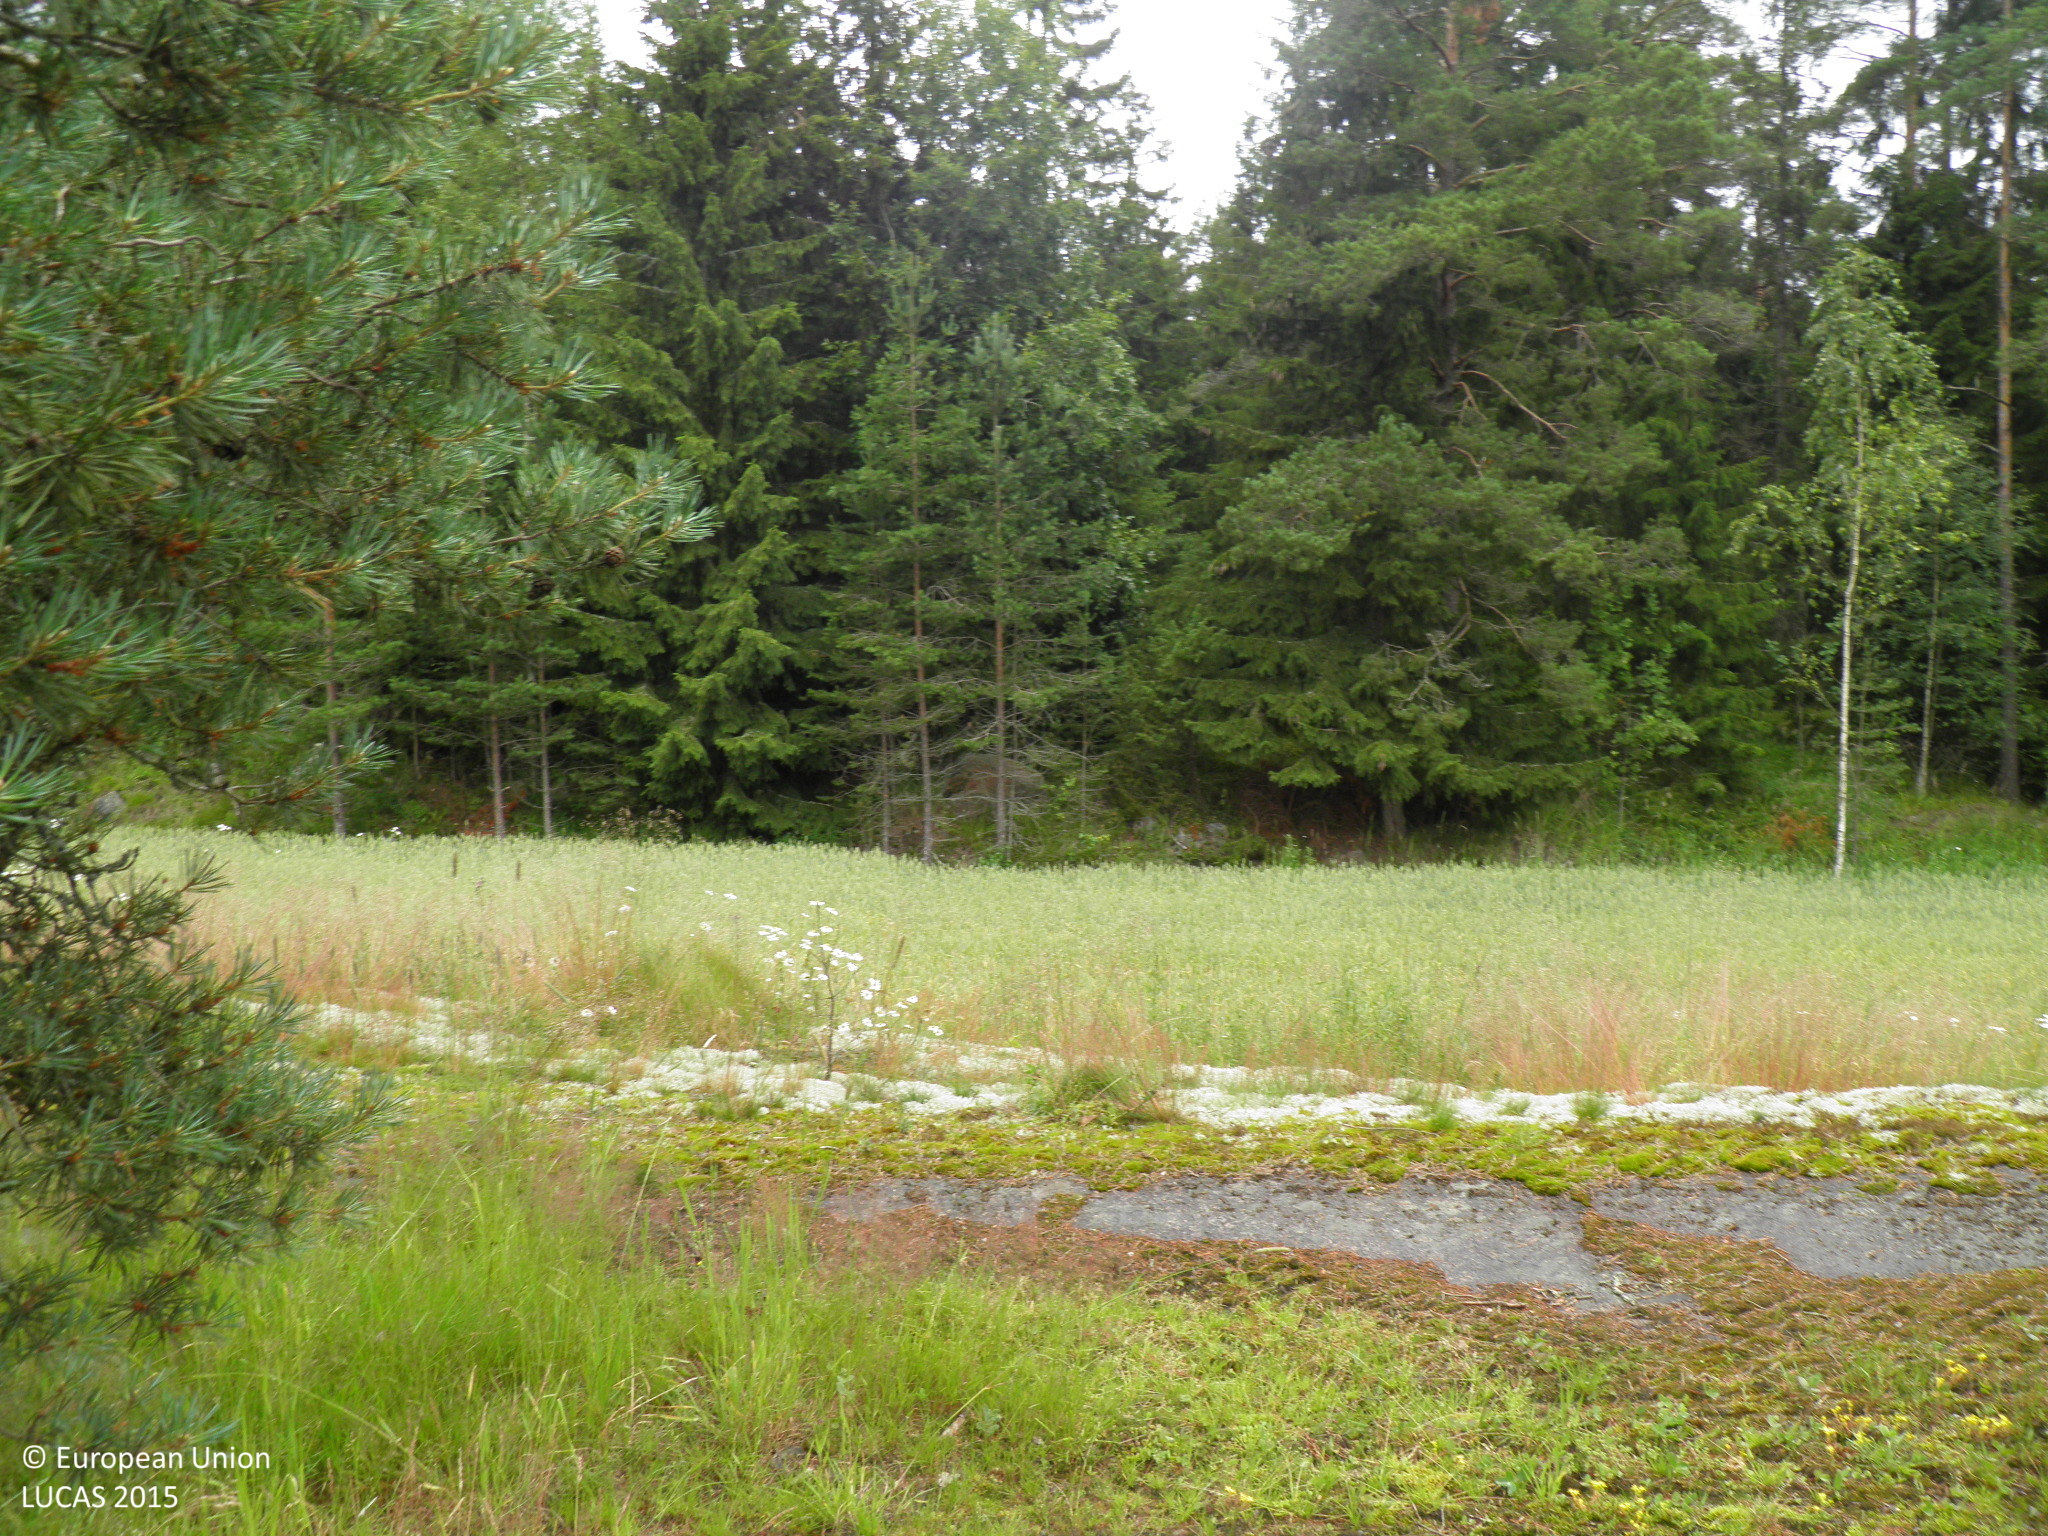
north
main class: Woodland
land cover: Pine dominated coniferous woodland
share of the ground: 10 - 25 %
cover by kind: herbaceous plants 30 %, lichens and mosses 30 %, coniferous forest trees 20 %, shrubs 10 %, consolidated bare surface 10 %
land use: Semi-natural and natural areas not in use
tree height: > 5 m
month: July
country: FI
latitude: 60.6572
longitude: 21.7117
